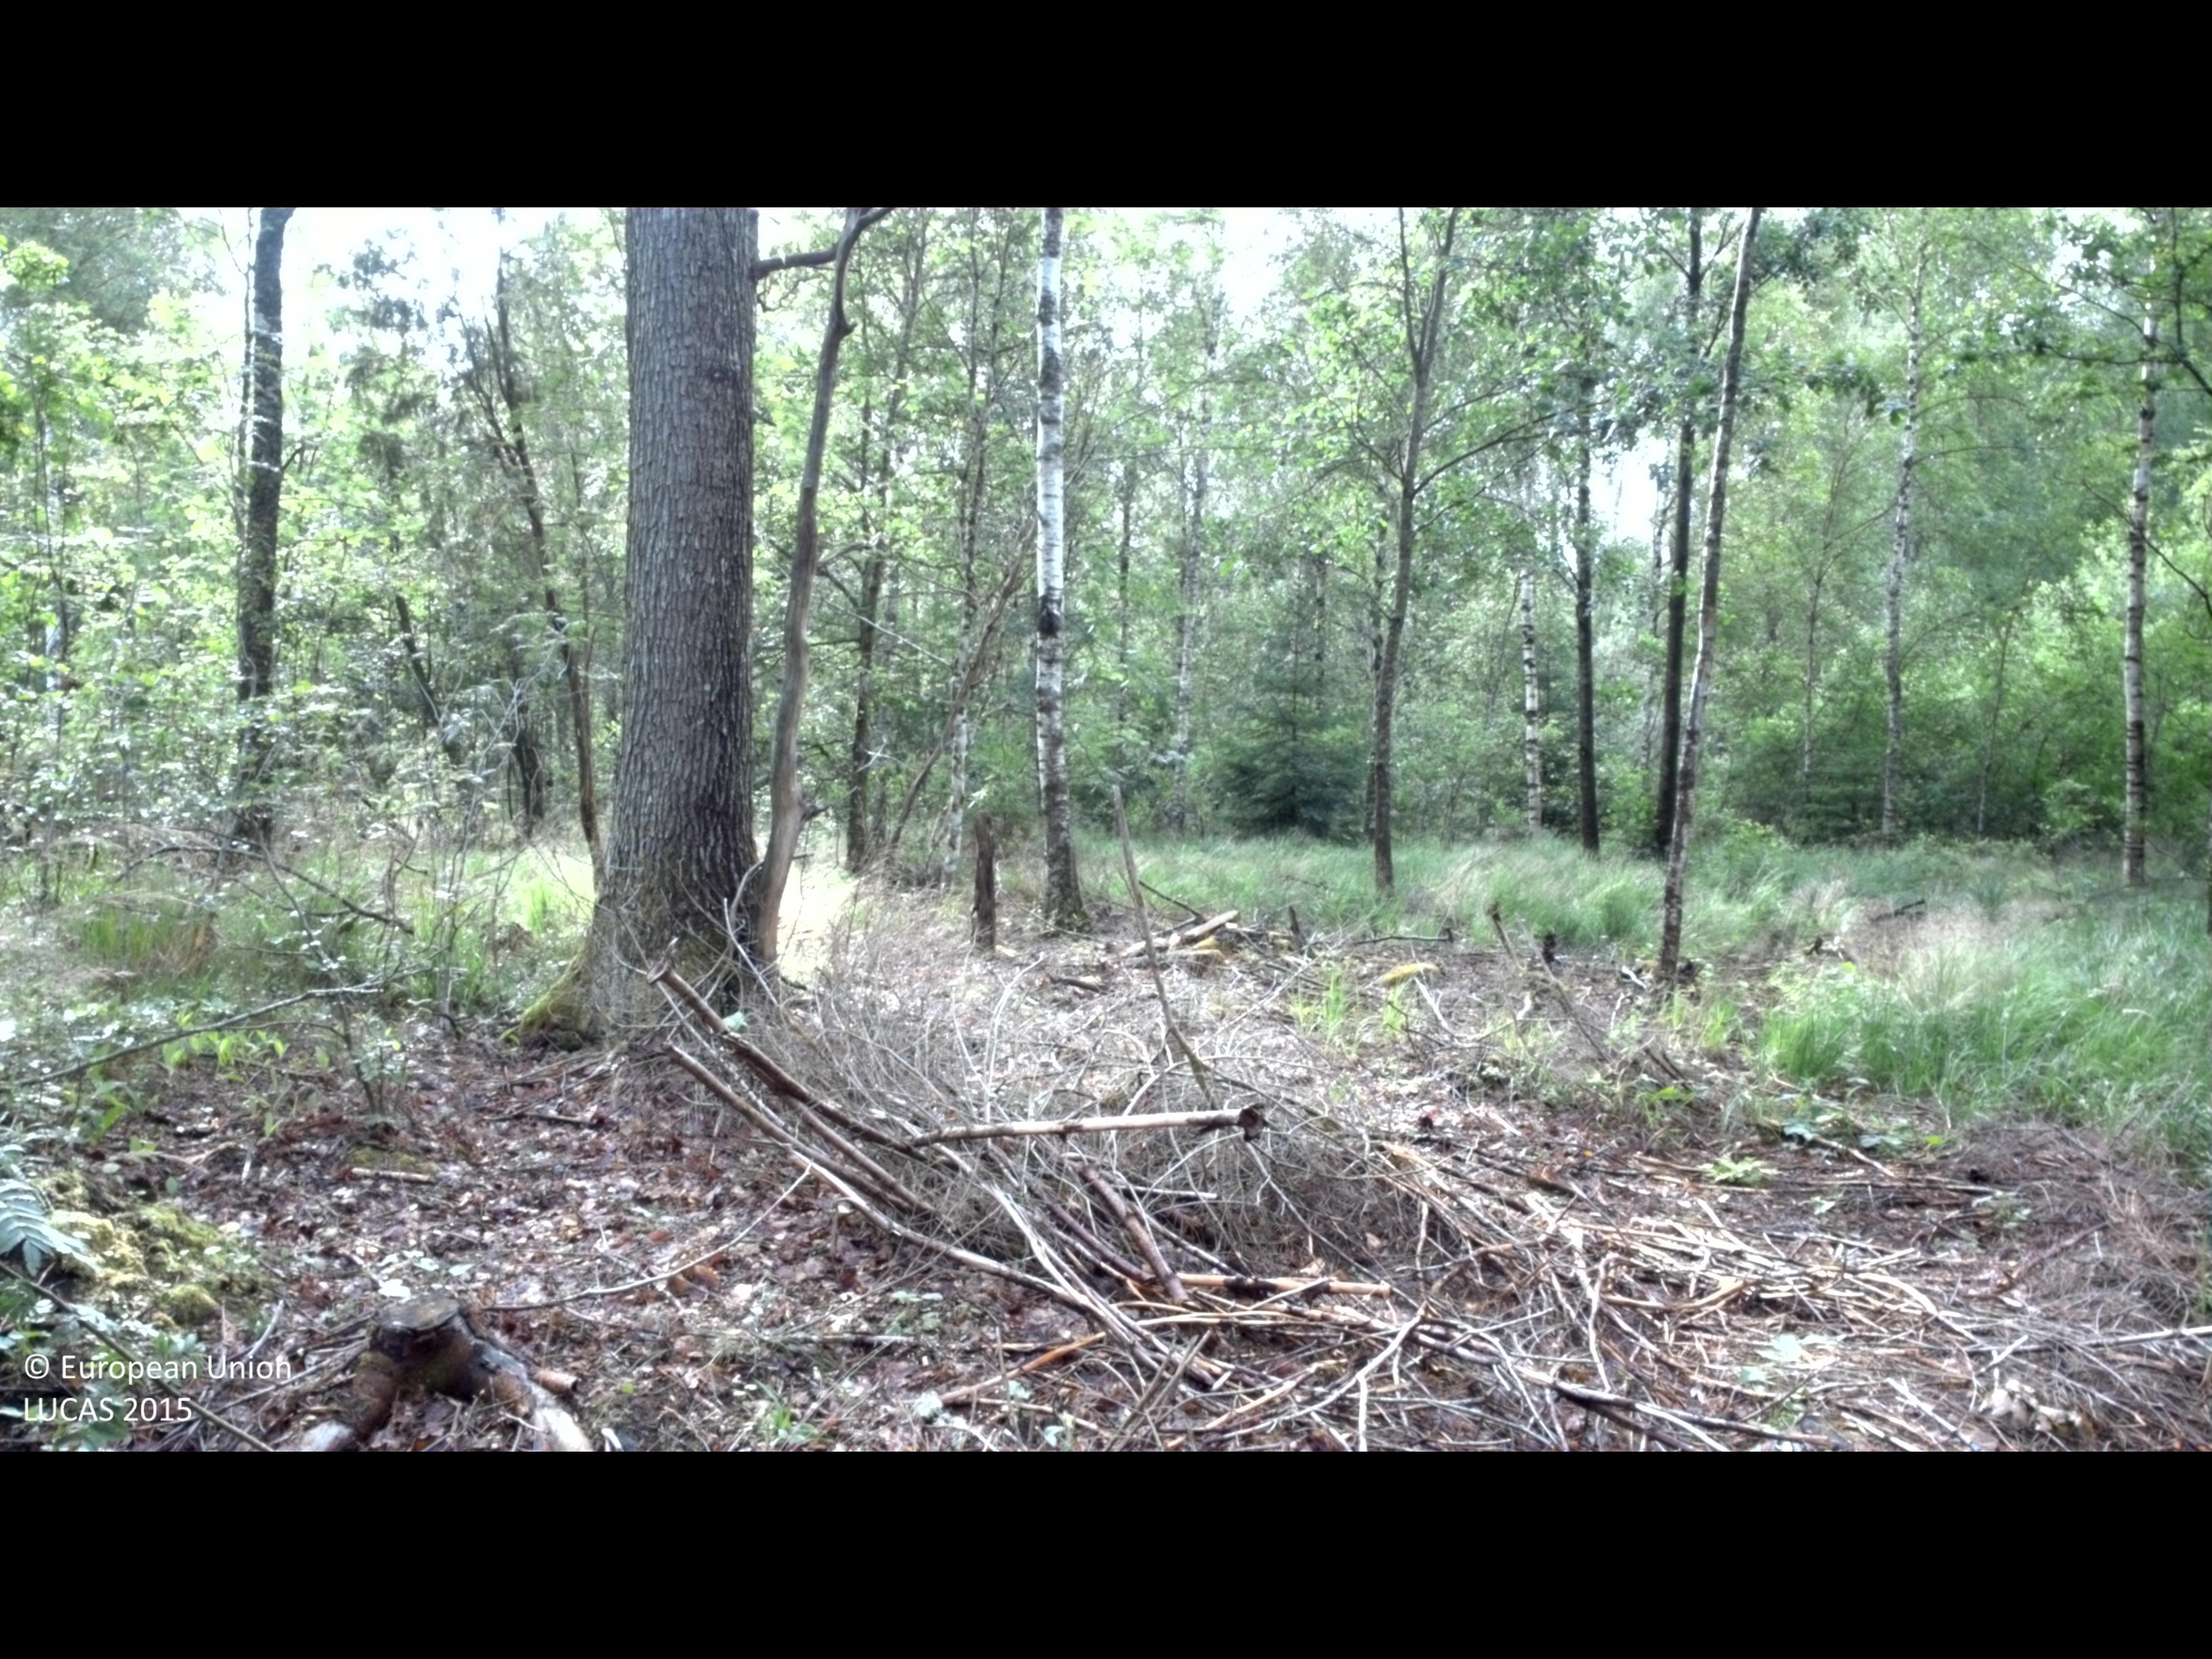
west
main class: Woodland
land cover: Broadleaved woodland
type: boreal forest
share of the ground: 50 - 75 %
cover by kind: broadleaved forest trees 55 %, herbaceous plants 30 %, shrubs 15 %
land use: Forestry
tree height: > 5 m
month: July
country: SE
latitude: 56.6546
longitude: 13.7648
